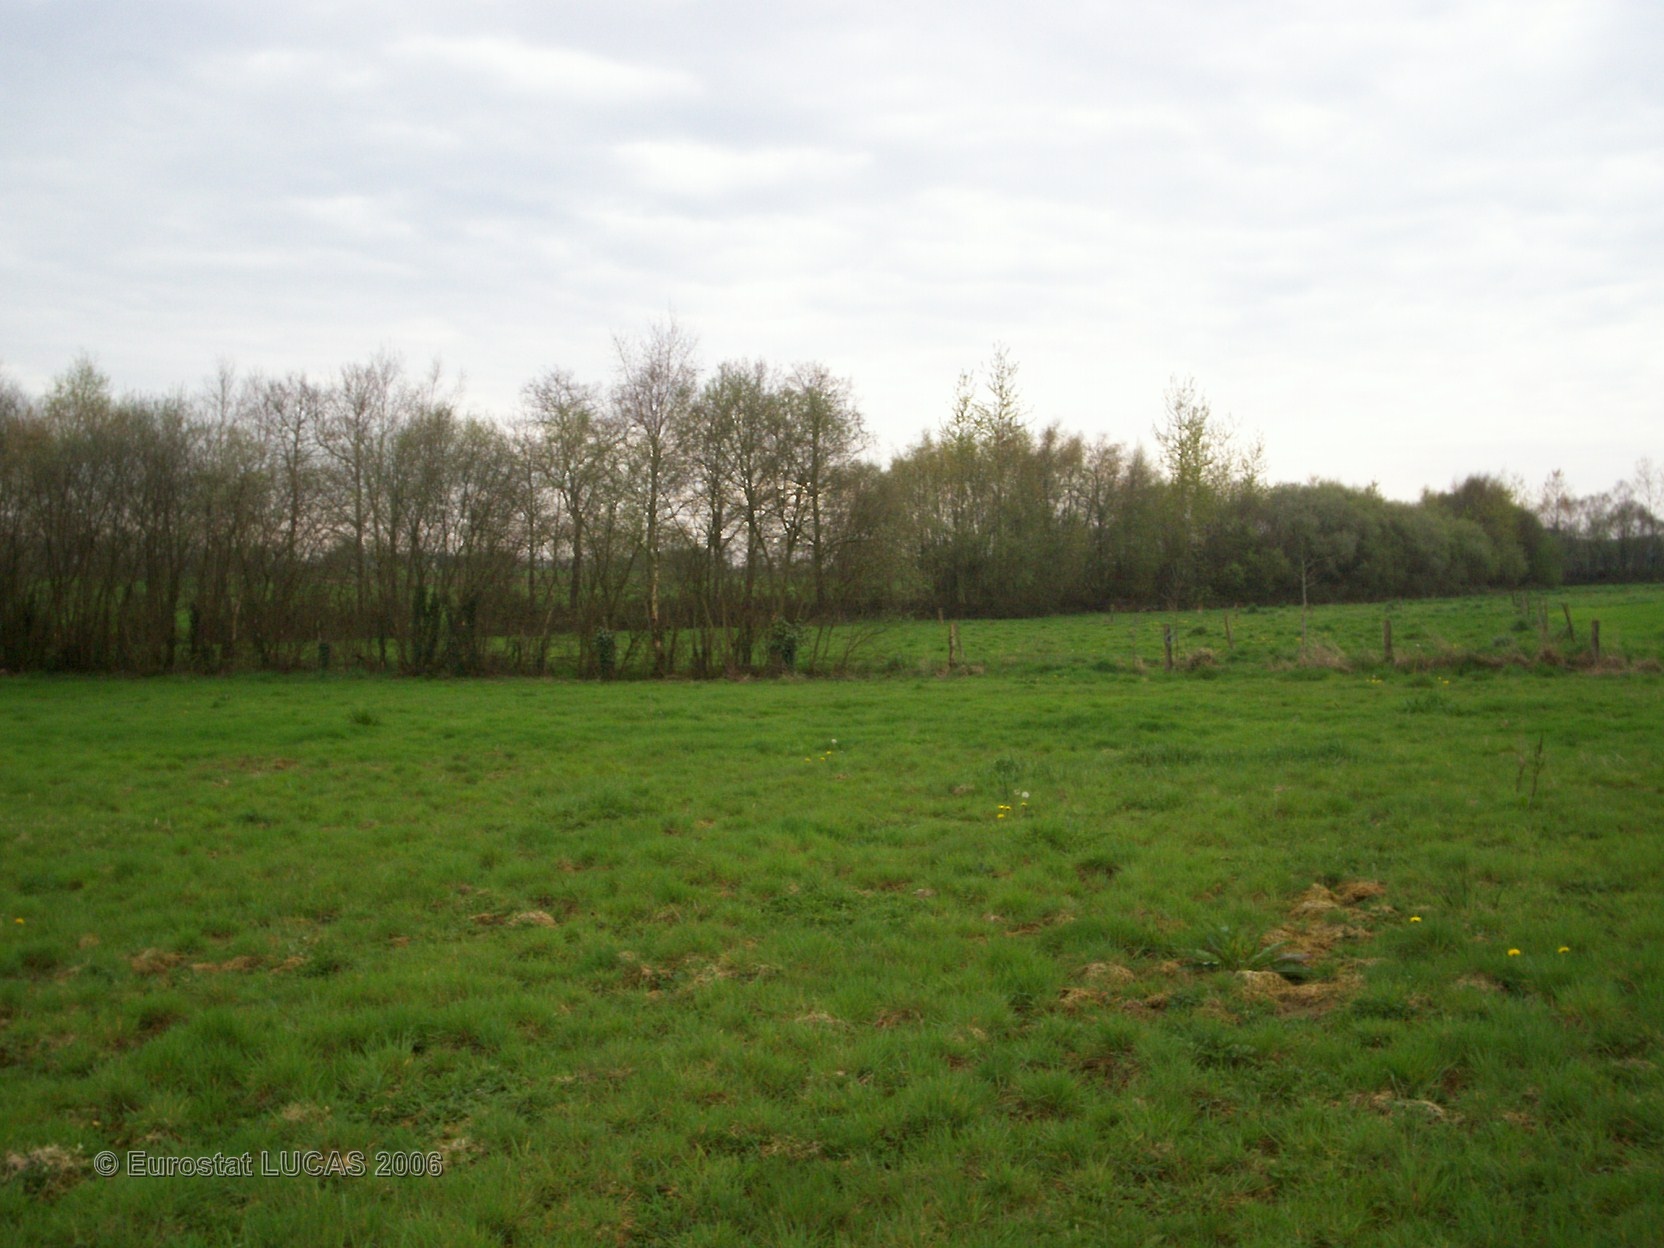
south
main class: Grassland
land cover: Grassland without tree/shrub cover
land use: Agriculture (excluding fallow land and kitchen gardens)
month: April
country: FR
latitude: 48.0330
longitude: -2.8461
